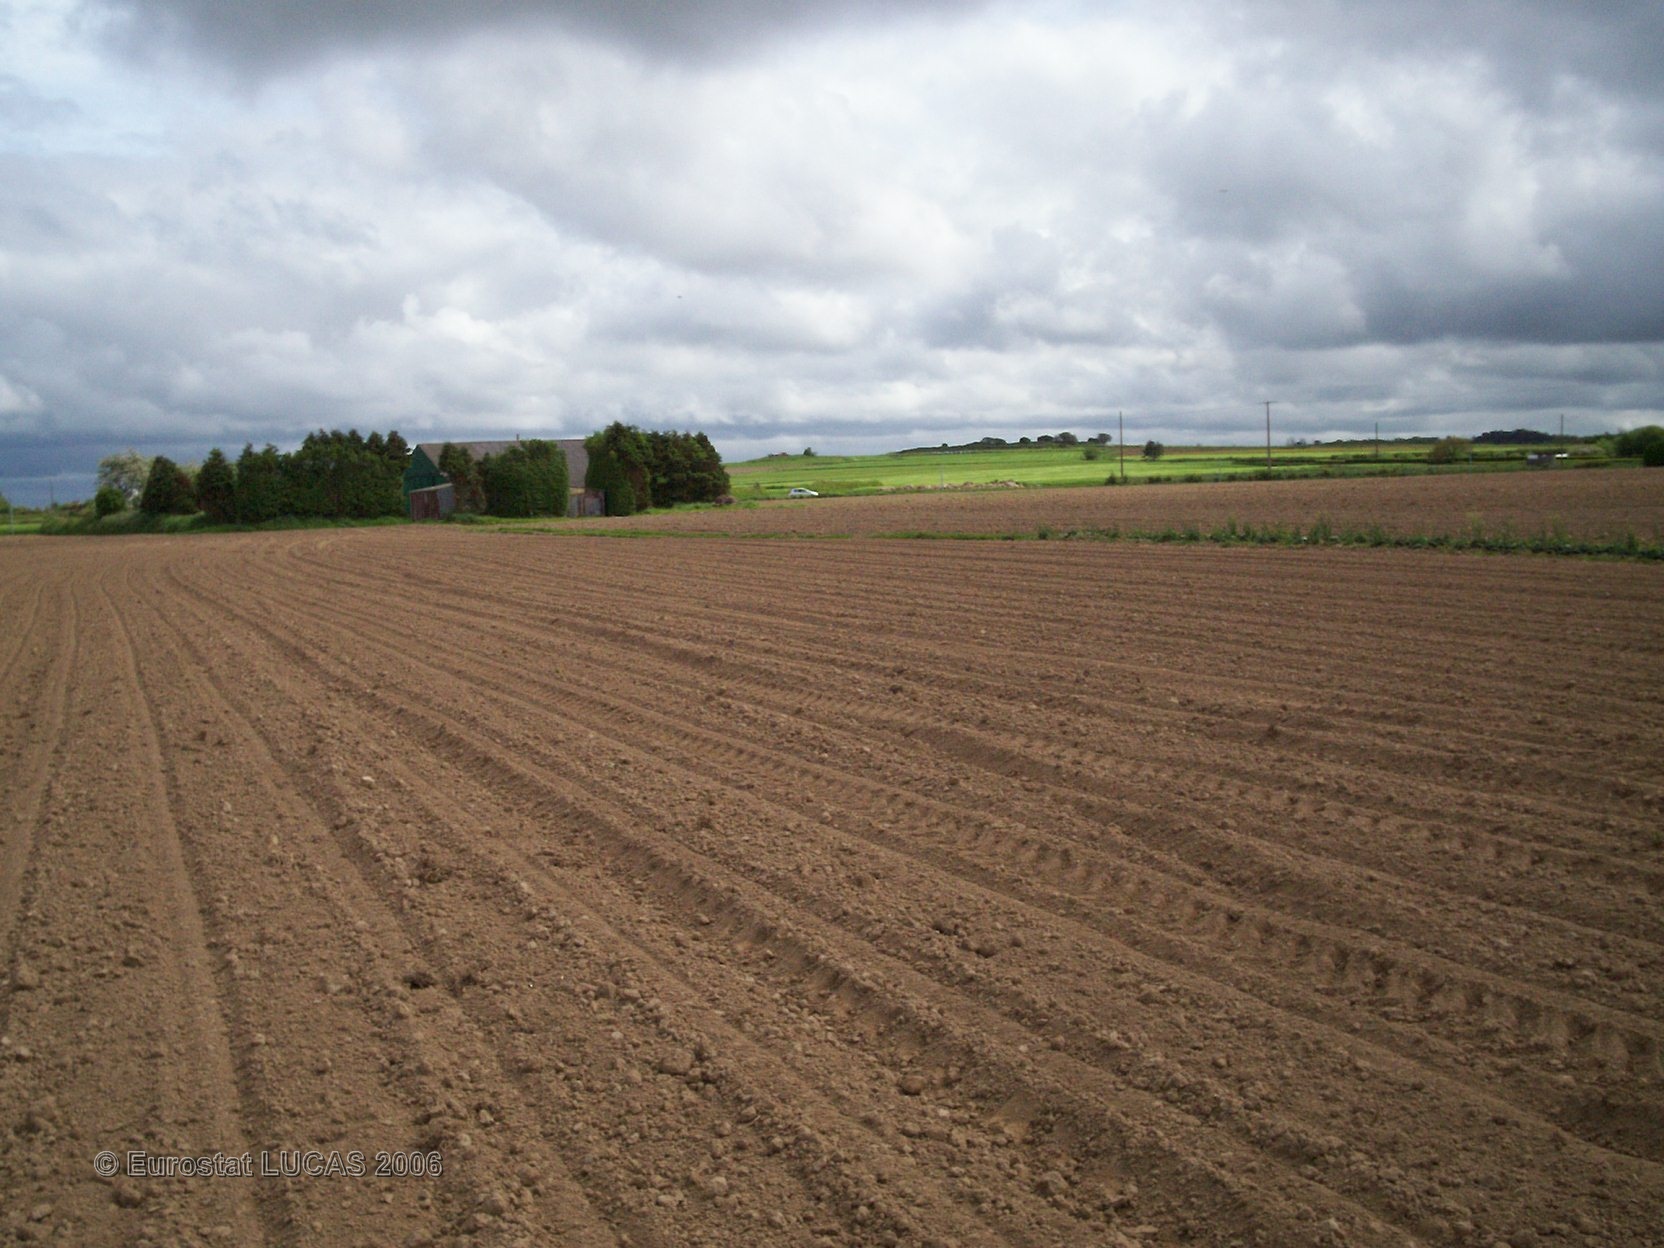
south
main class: Cropland
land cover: Maize
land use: Agriculture (excluding fallow land and kitchen gardens)
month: May
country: FR
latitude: 48.6731
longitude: -3.7320
